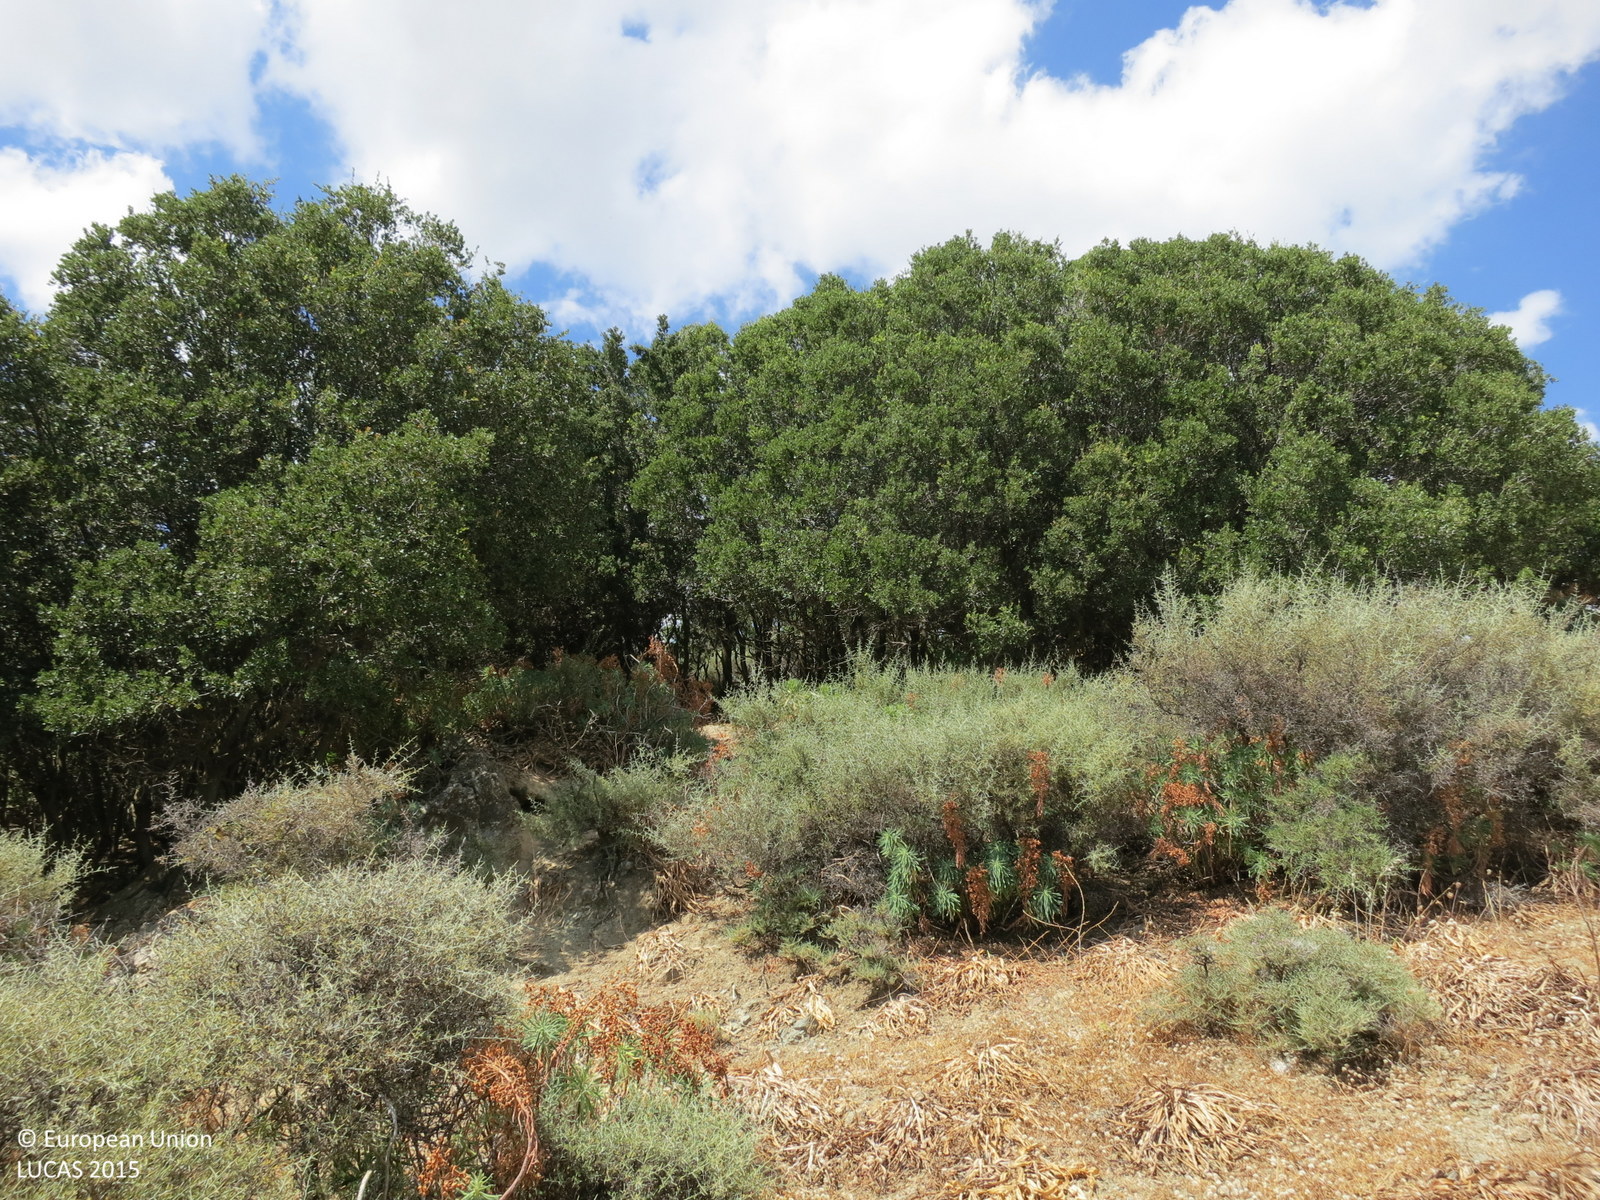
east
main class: Shrubland
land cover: Shrubland with sparse tree cover
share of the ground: > 75 %
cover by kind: shrubs 80 %, herbaceous plants 15 %, broadleaved forest trees 5 %
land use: Abandoned areas
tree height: < 5 m
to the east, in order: Shrubland with sparse tree cover; Grassland with sparse tree/shrub cover; Shrubland with sparse tree cover; Fences; Olive groves; Dry stone walls; Olive groves; Abandoned hedges; Fences; Tracks; Shrubland with sparse tree cover
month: June
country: GR
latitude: 35.1435
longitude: 24.8146
